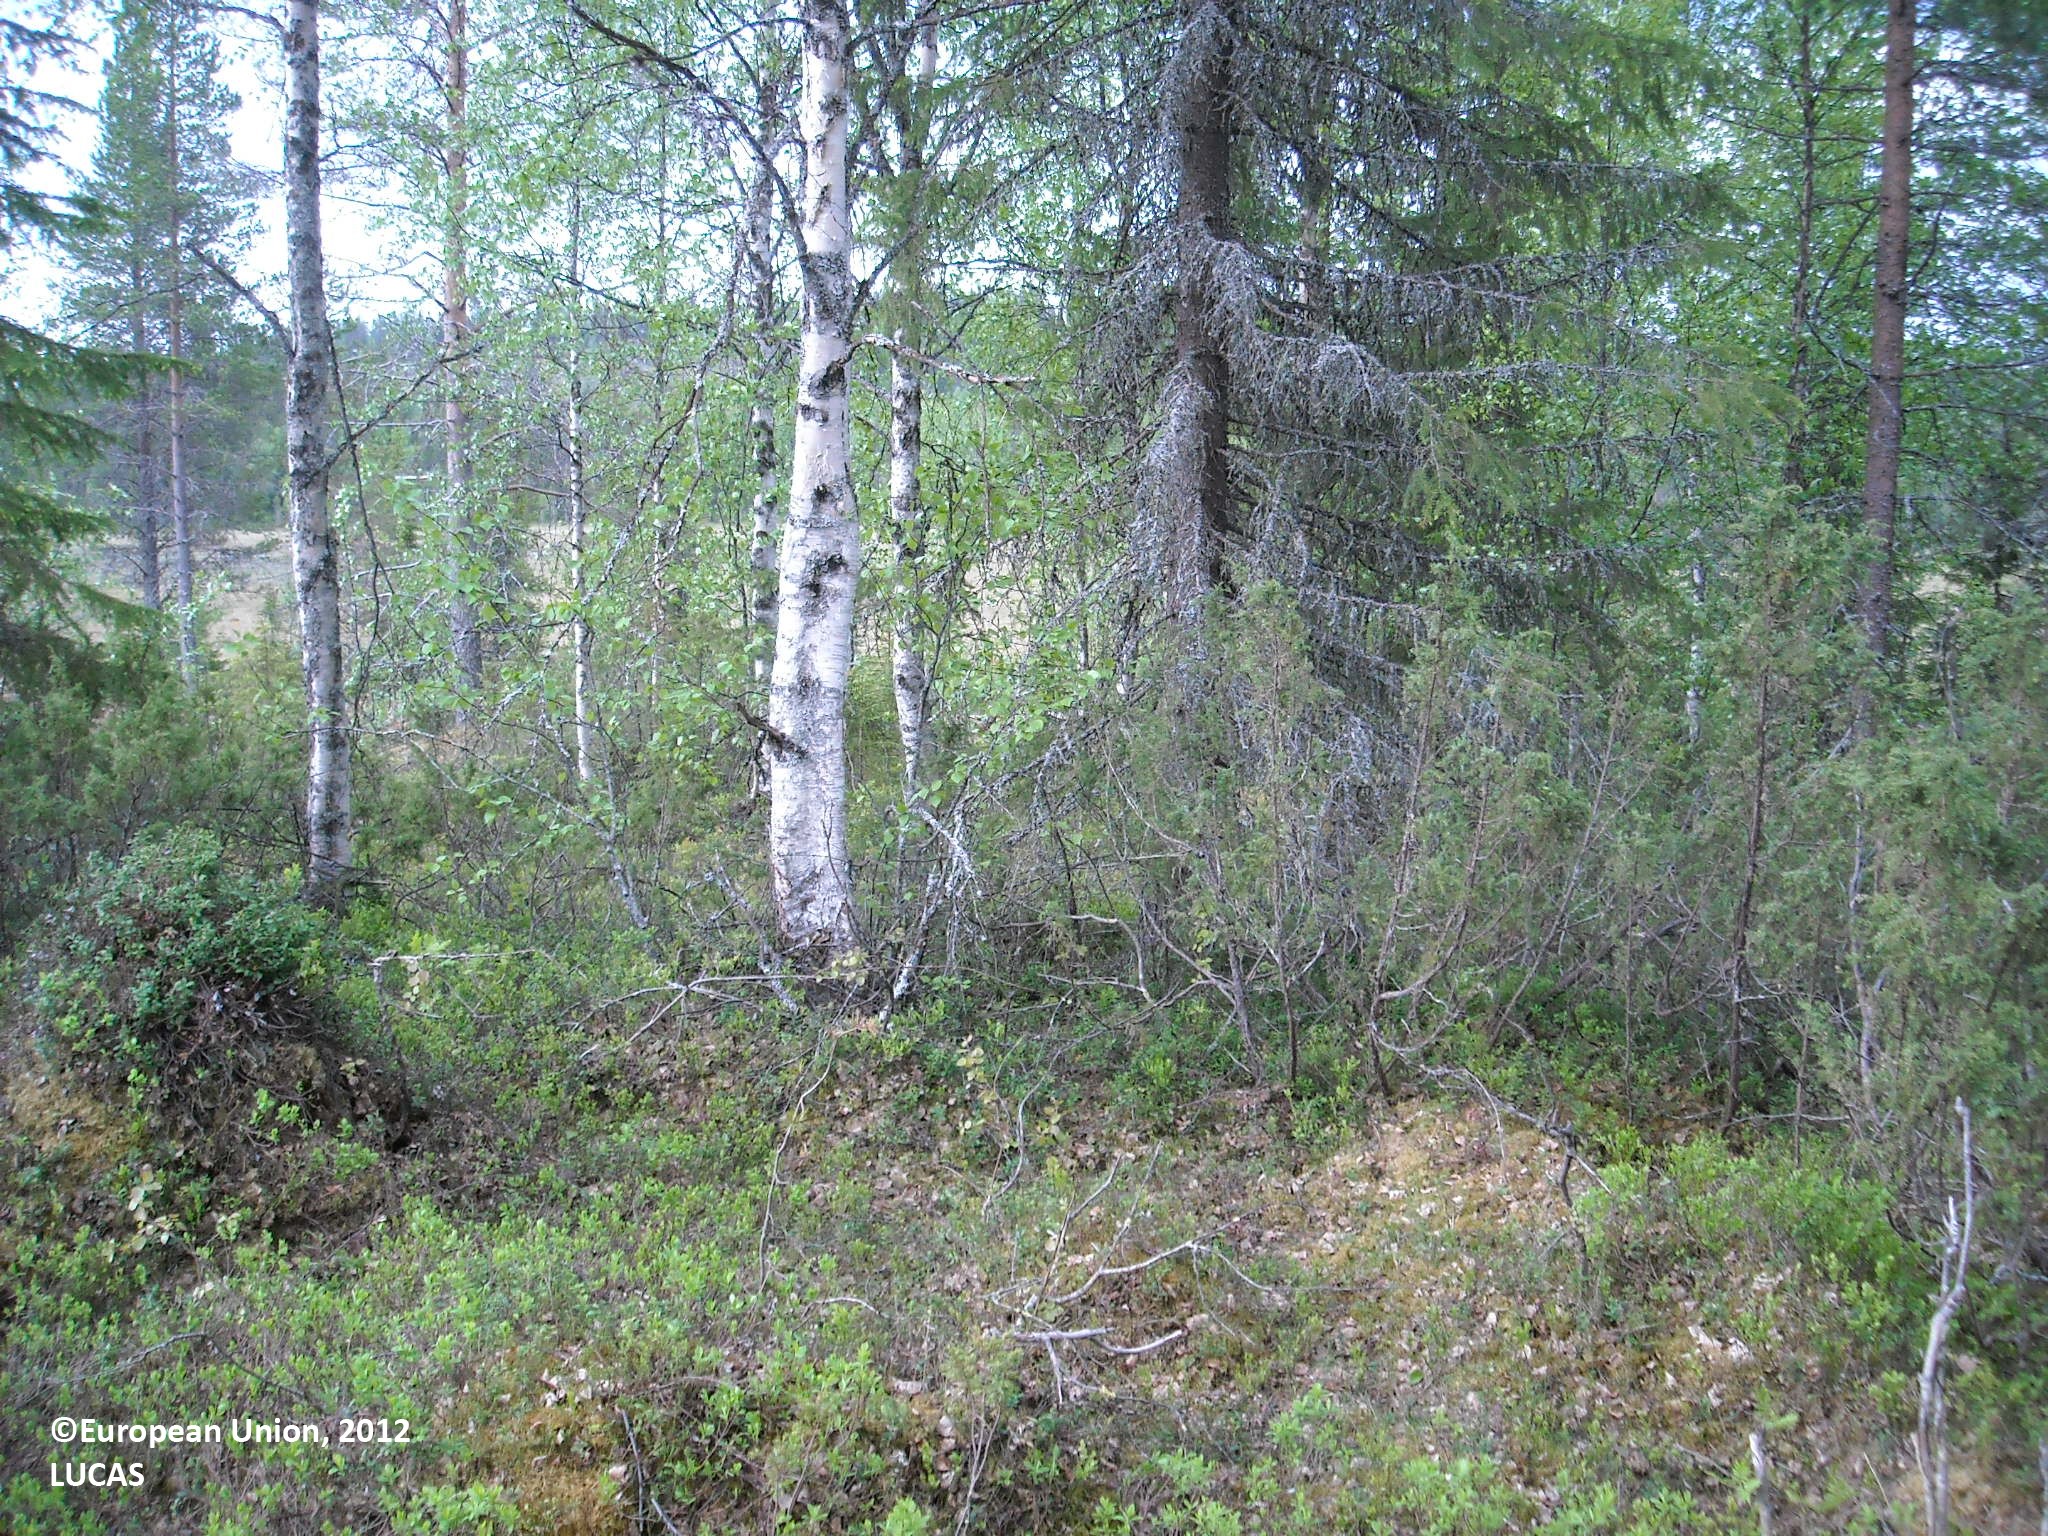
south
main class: Woodland
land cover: Other mixed woodland
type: boreal forest
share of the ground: > 75 %
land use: Forestry
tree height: > 5 m
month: June
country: FI
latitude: 65.6510
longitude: 27.9882
